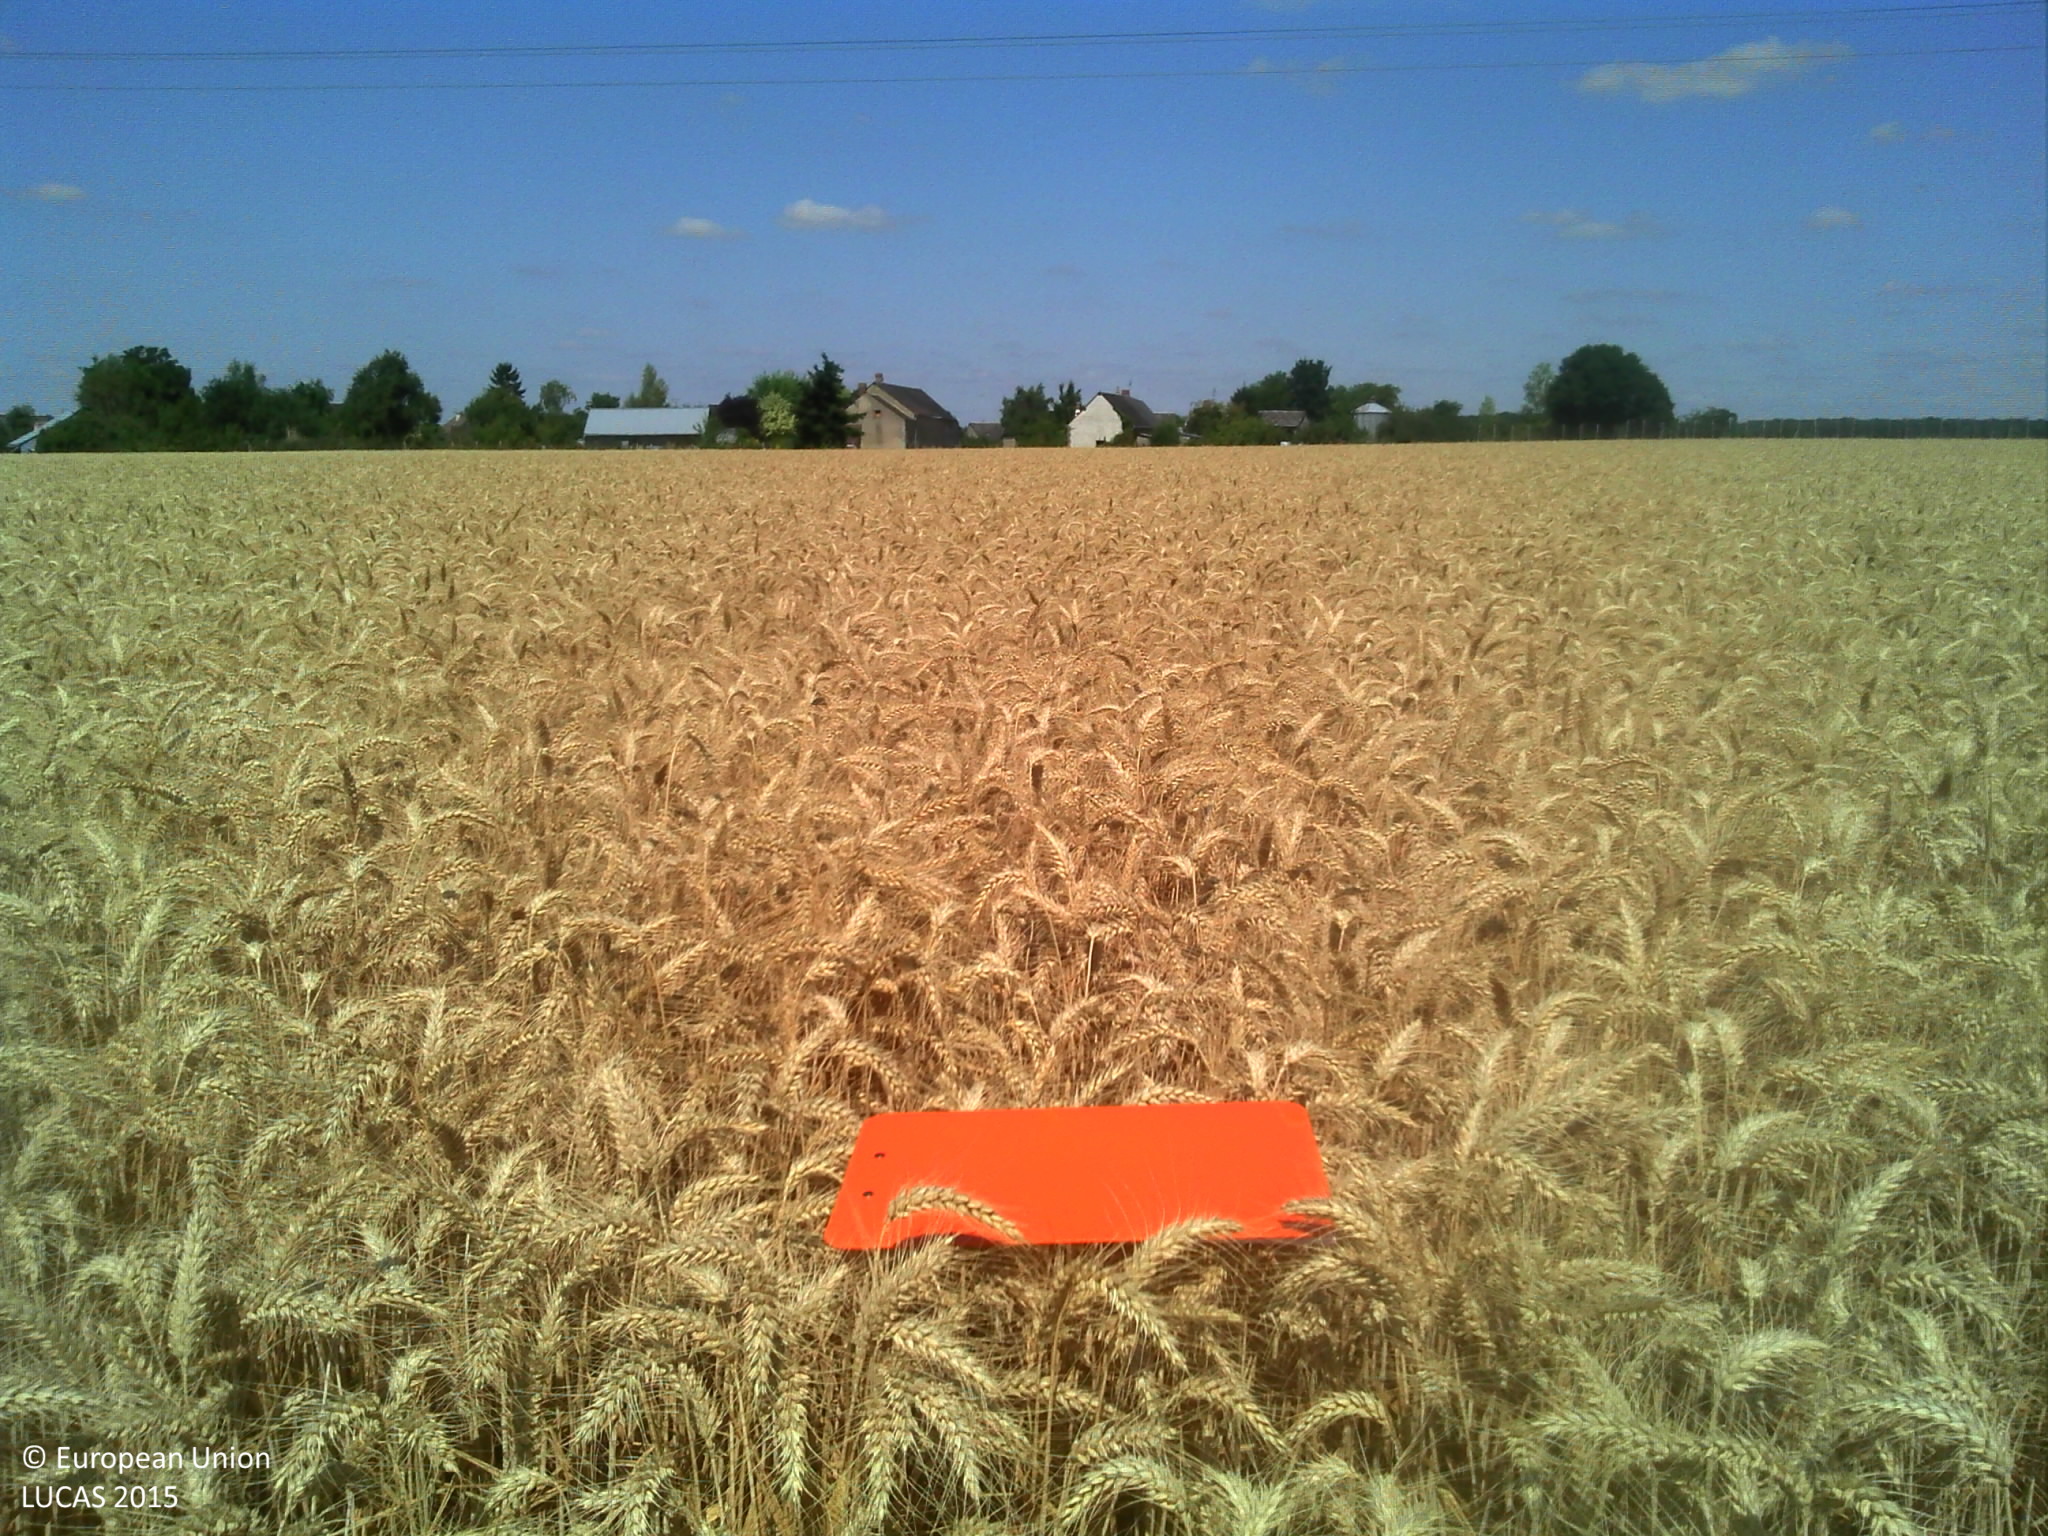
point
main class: Cropland
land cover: Common wheat
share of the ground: > 75 %
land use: Agriculture (excluding fallow land and kitchen gardens)
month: July
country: FR
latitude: 48.1137
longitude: 1.2921
